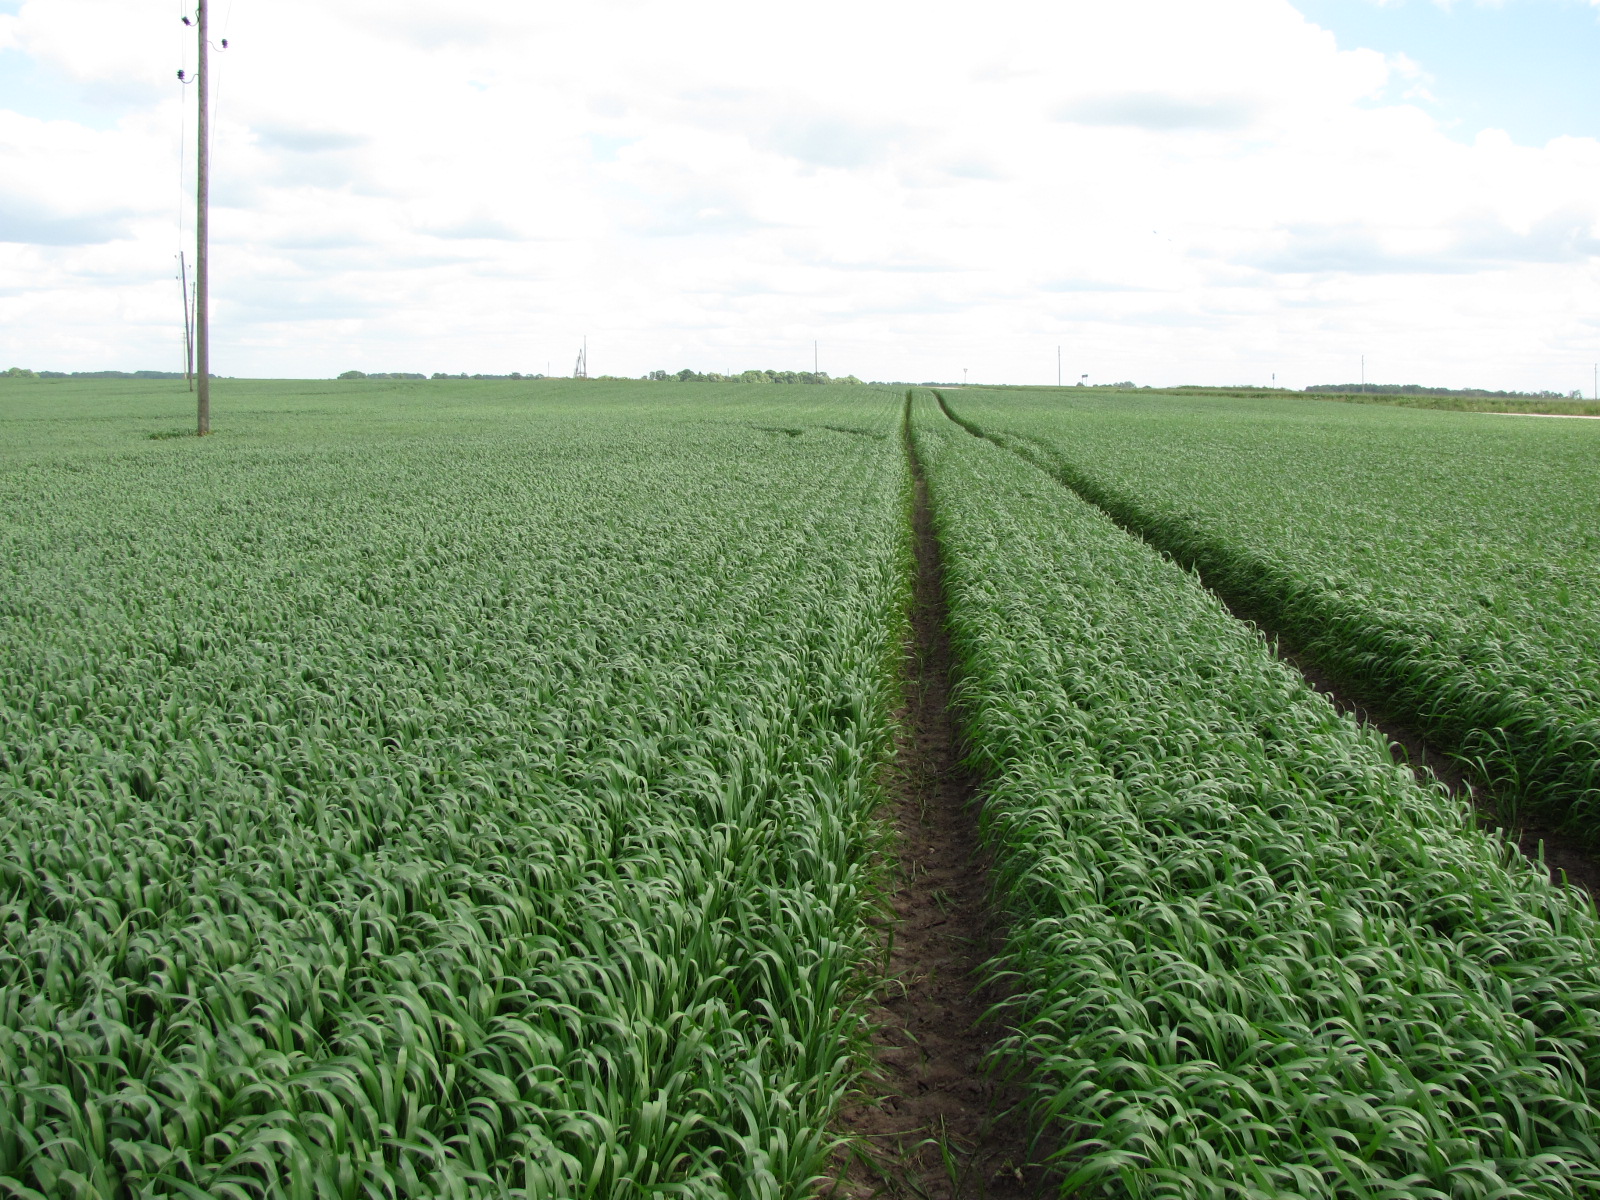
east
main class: Cropland
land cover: Common wheat
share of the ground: > 75 %
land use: Agriculture (excluding fallow land and kitchen gardens)
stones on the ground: < 10 %
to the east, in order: Common wheat; Electric lines; Common wheat; Grass margins; Paved roads, cycling and walking lanes; Grassland without tree/shrub cover
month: June
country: LV
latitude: 56.2894
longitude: 24.1942
